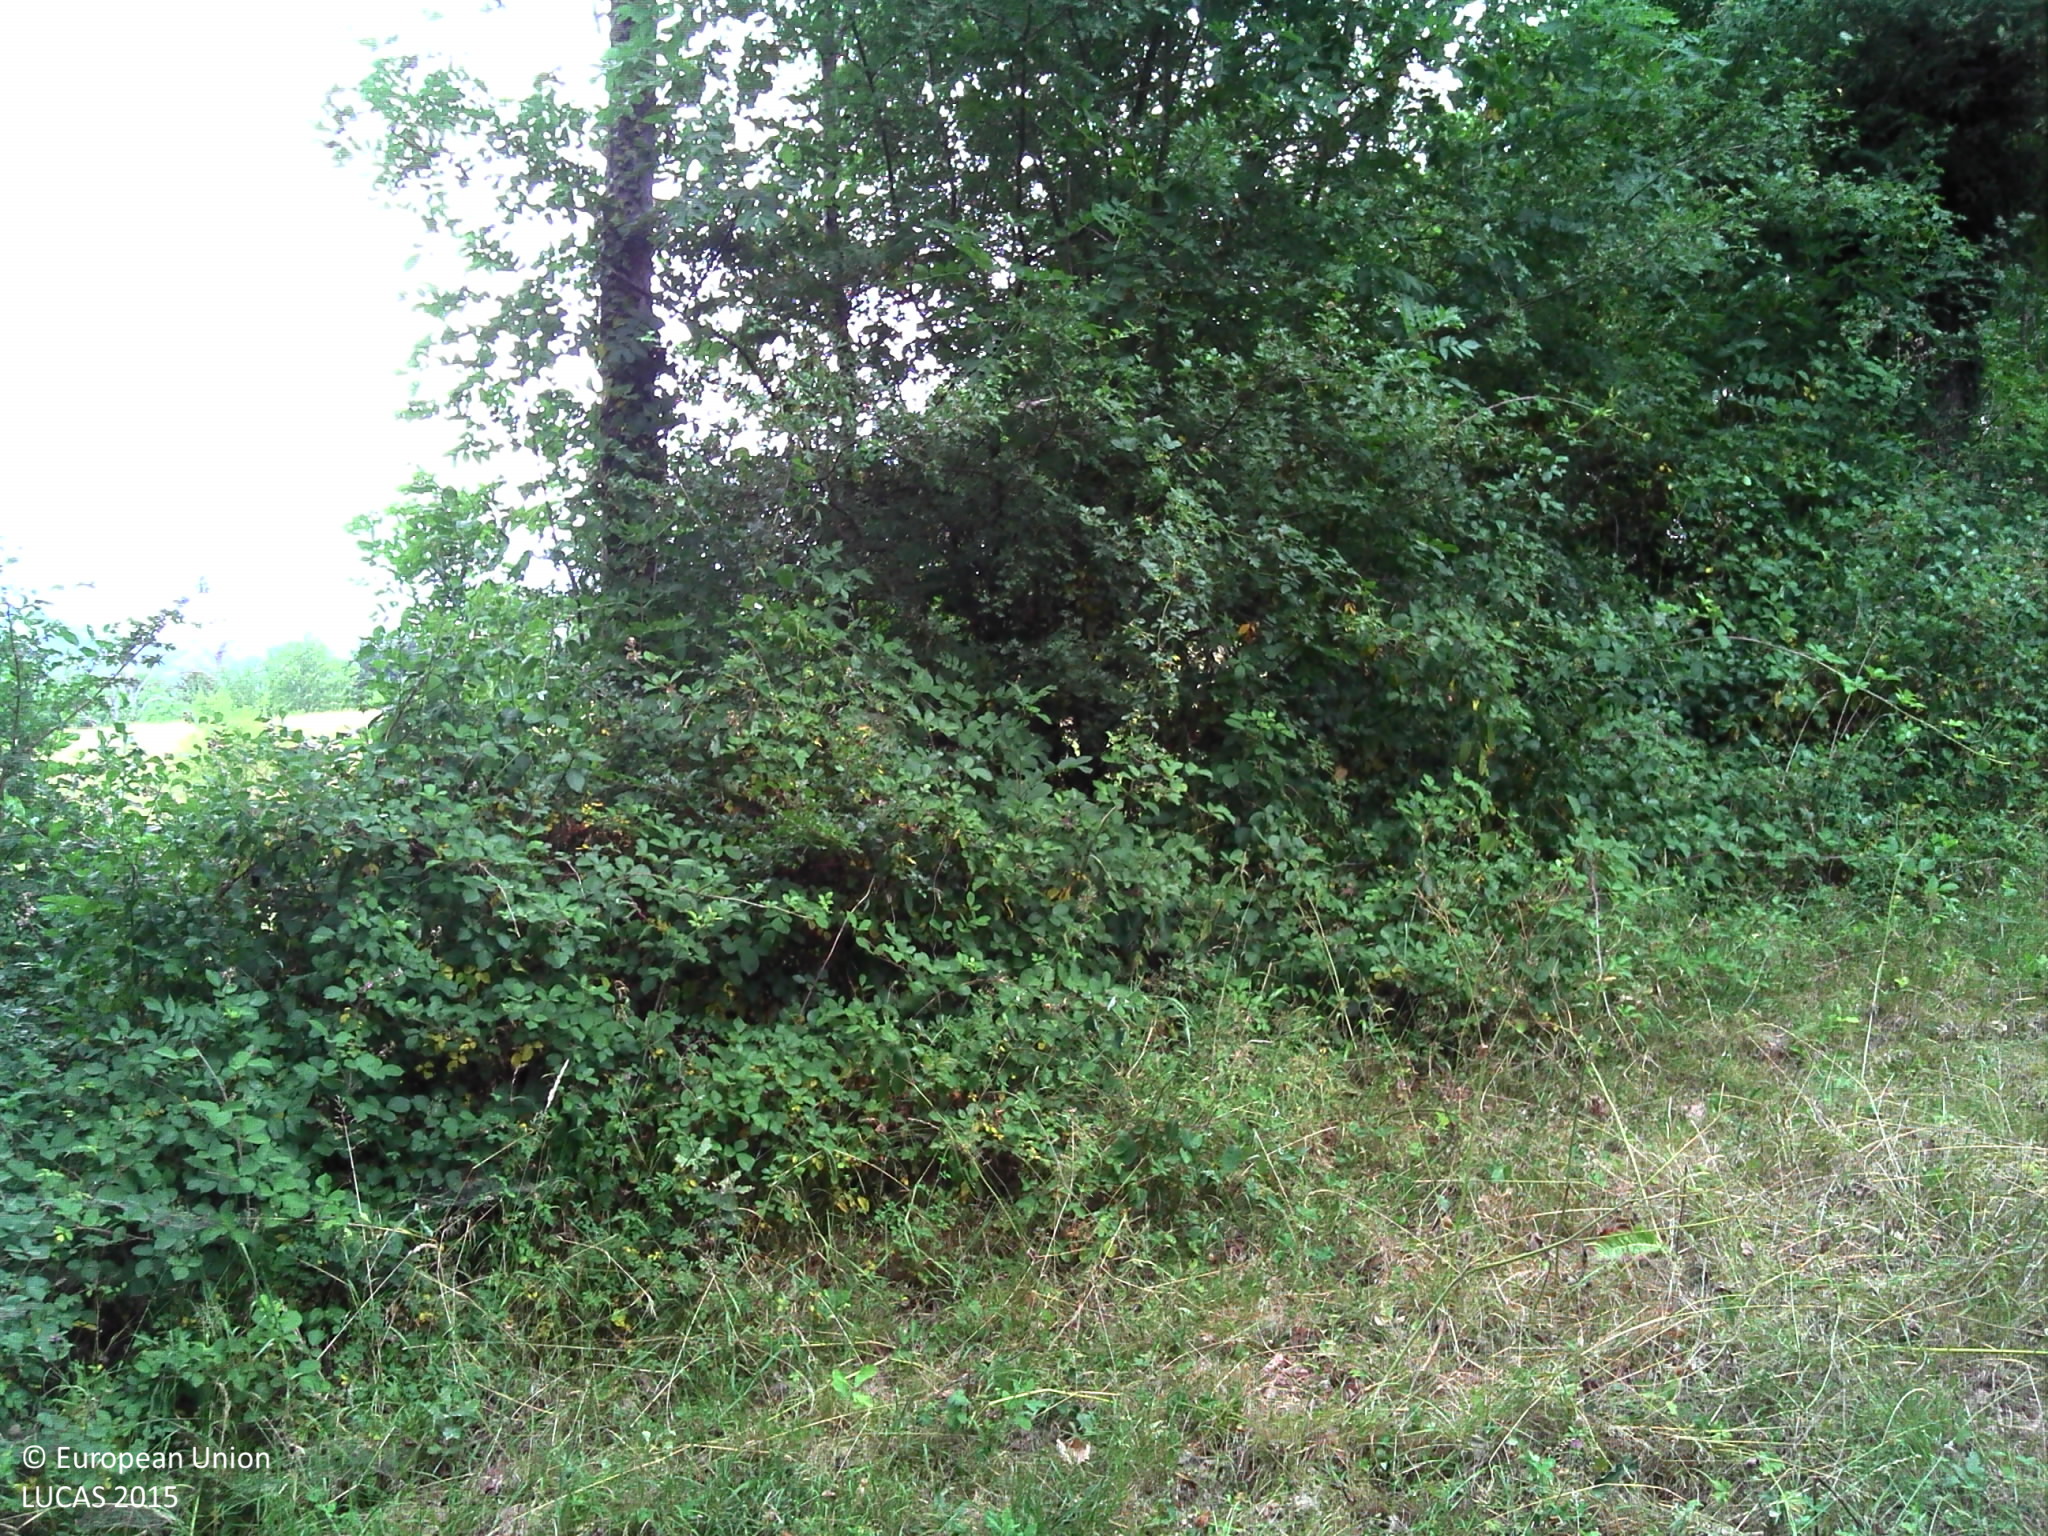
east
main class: Woodland
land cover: Broadleaved woodland
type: mesophytic deciduous forest
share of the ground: > 75 %
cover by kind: broadleaved forest trees 85 %, shrubs 10 %, lichens and mosses 5 %
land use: Forestry
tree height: > 5 m
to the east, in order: Broadleaved woodland; Fences; Broadleaved woodland; Dry stone walls; Fences; Broadleaved woodland; Grassland without tree/shrub cover; Broadleaved woodland; Grassland without tree/shrub cover; Fences; Broadleaved woodland
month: July
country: FR
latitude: 44.4436
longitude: 3.0561
